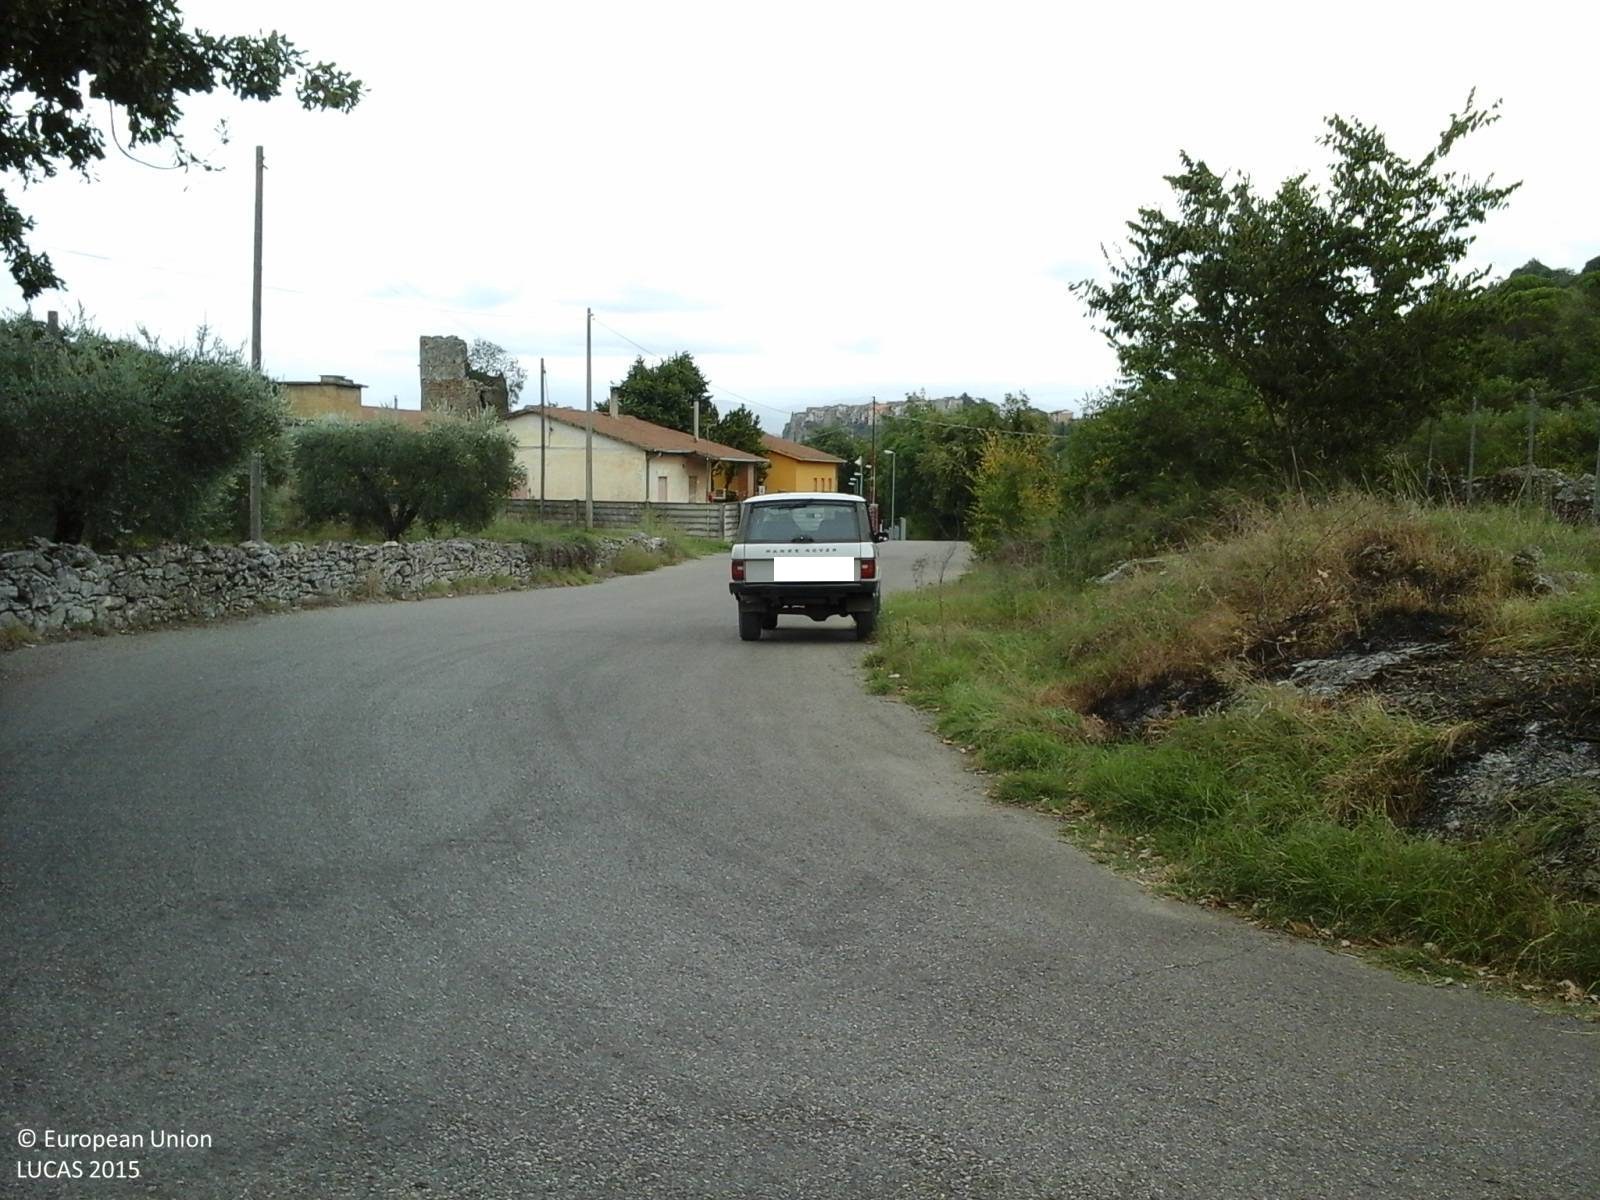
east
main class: Woodland
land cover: Broadleaved woodland
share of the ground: > 75 %
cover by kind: broadleaved forest trees 100 %
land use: Residential
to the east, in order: Broadleaved woodland; Artificial constructions in urban areas; Olive groves; Electric lines; Olive groves; Grassland without tree/shrub cover; Artificial constructions in urban areas; Broadleaved woodland; Tracks; Broadleaved woodland; Electric lines; Broadleaved woodland
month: September
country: IT
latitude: 42.4638
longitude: 12.3636
